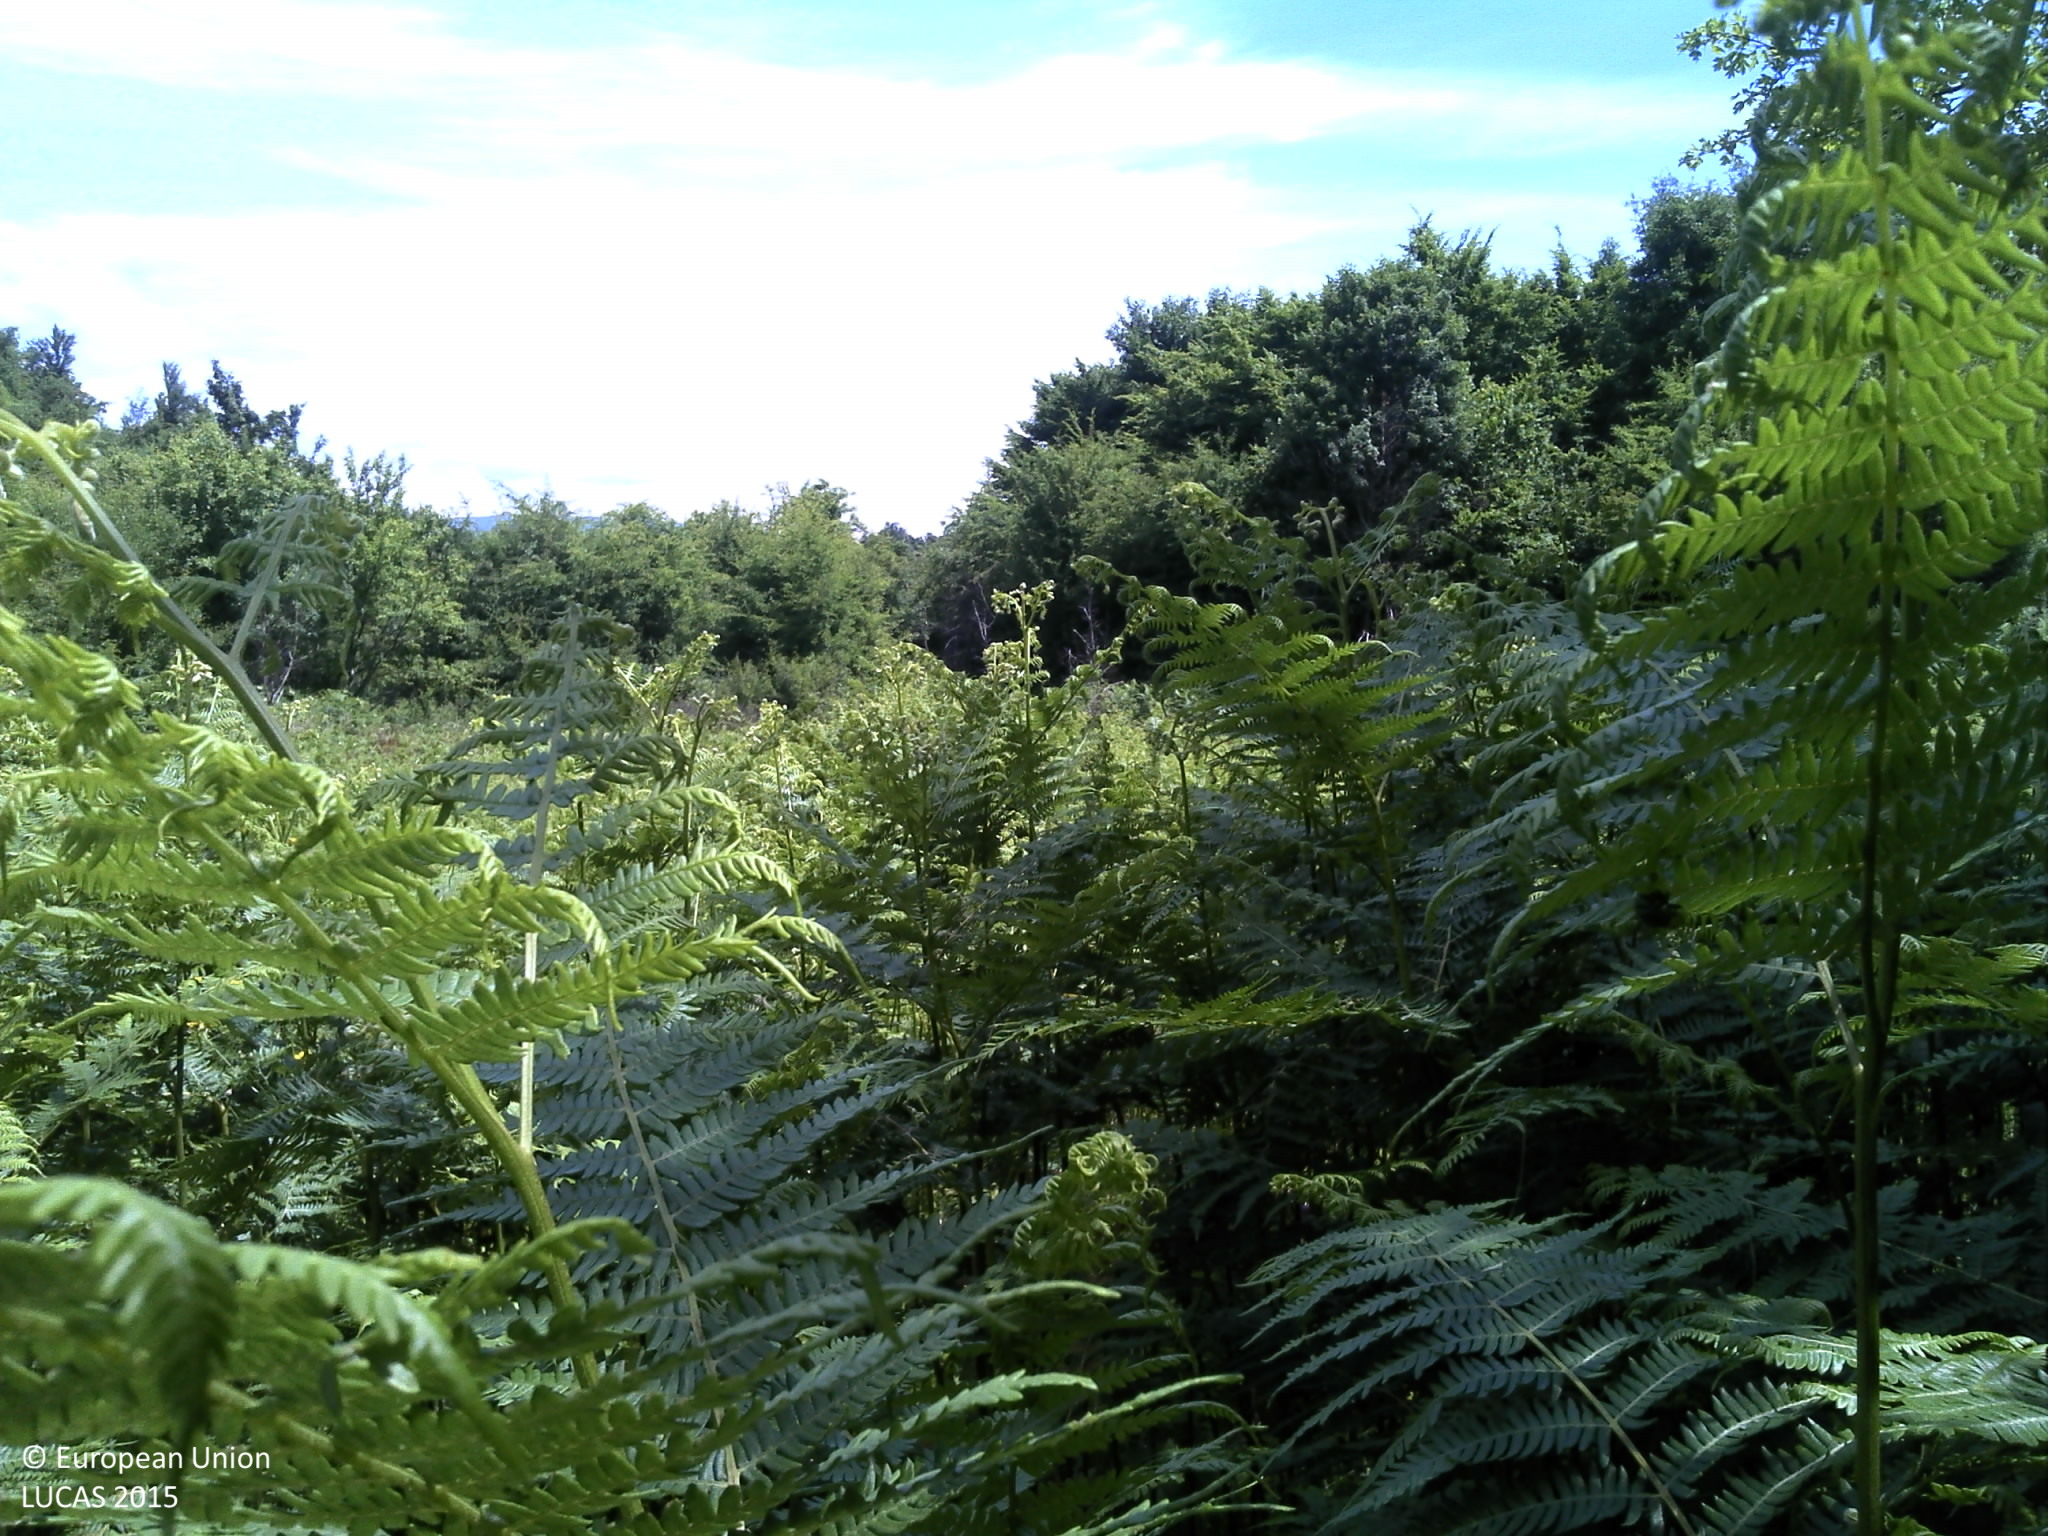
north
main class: Woodland
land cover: Broadleaved woodland
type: beech forest
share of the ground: > 75 %
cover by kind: broadleaved forest trees 95 %, herbaceous plants 5 %
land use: Semi-natural and natural areas not in use
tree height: > 5 m
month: June
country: HR
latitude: 44.5358
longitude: 16.0473
